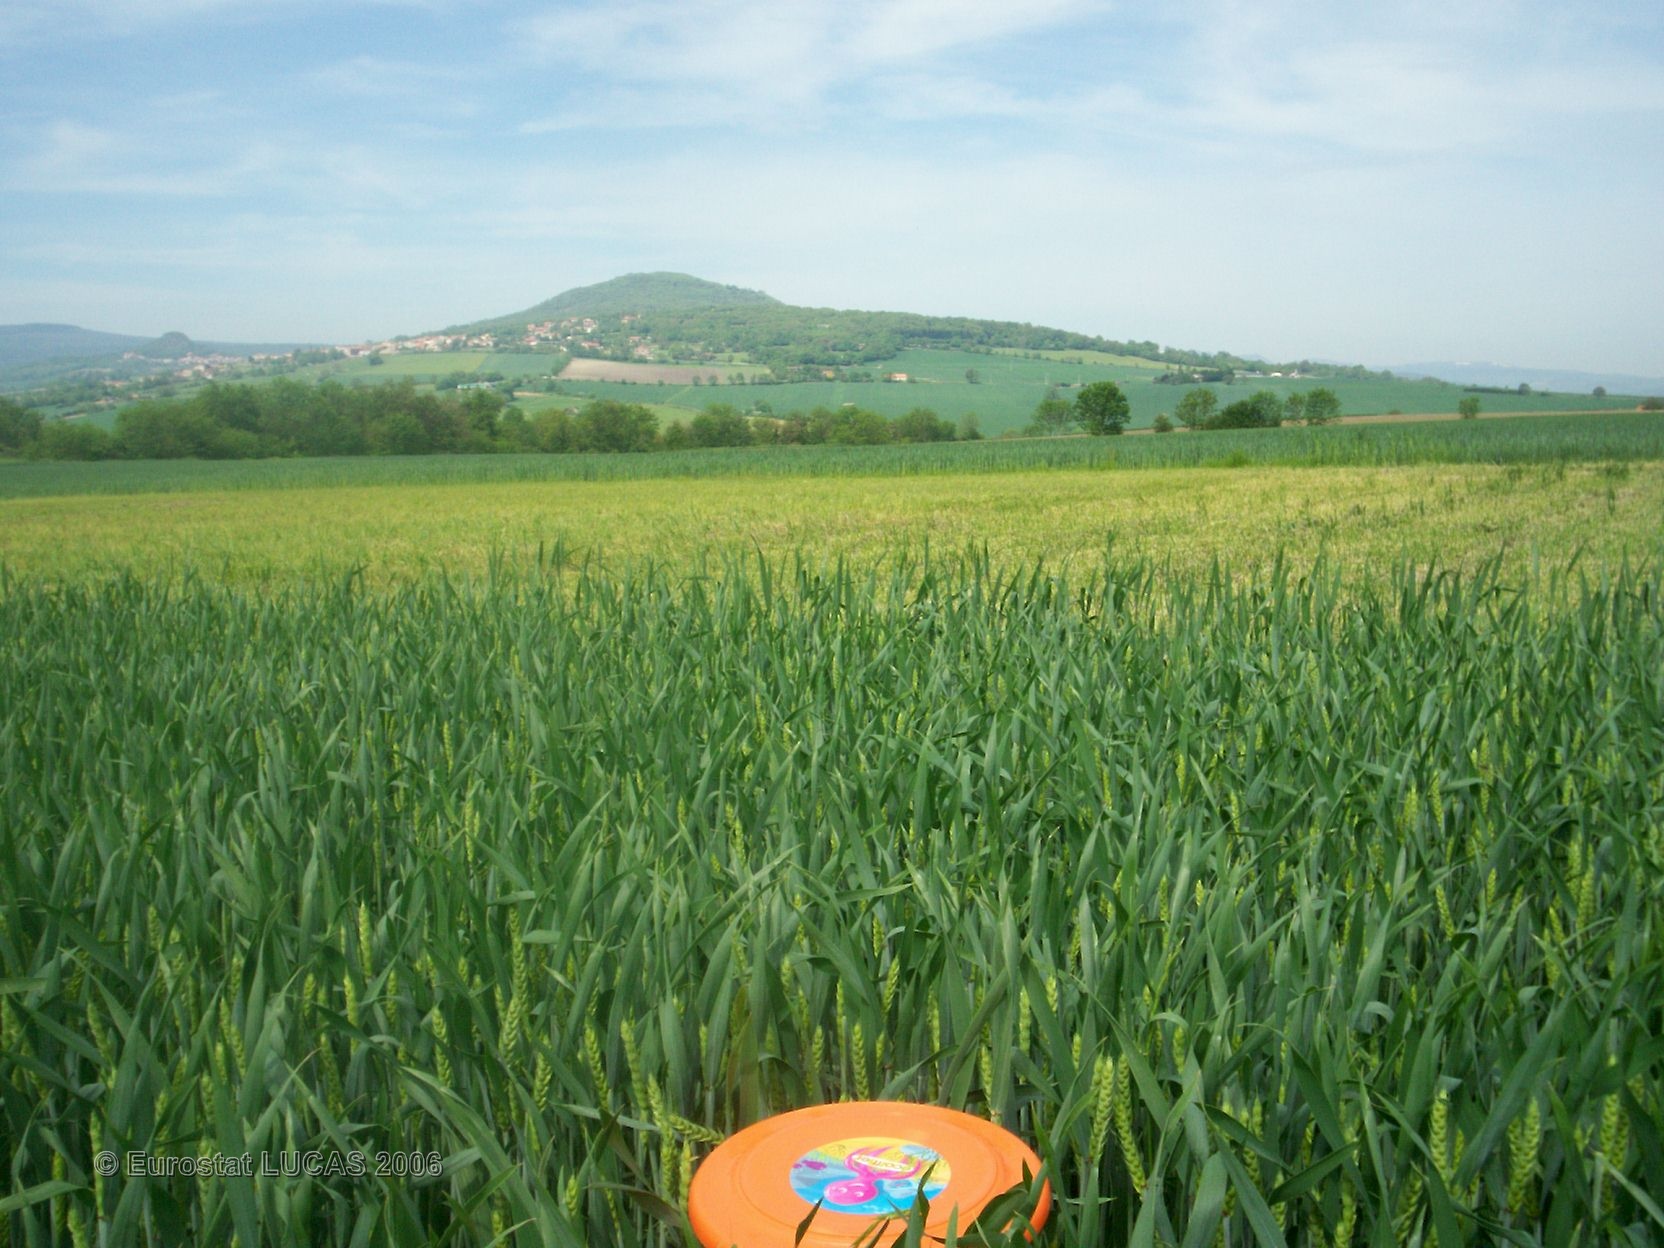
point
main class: Cropland
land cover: Common wheat
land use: Agriculture (excluding fallow land and kitchen gardens)
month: May
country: FR
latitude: 45.5203
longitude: 3.2029
